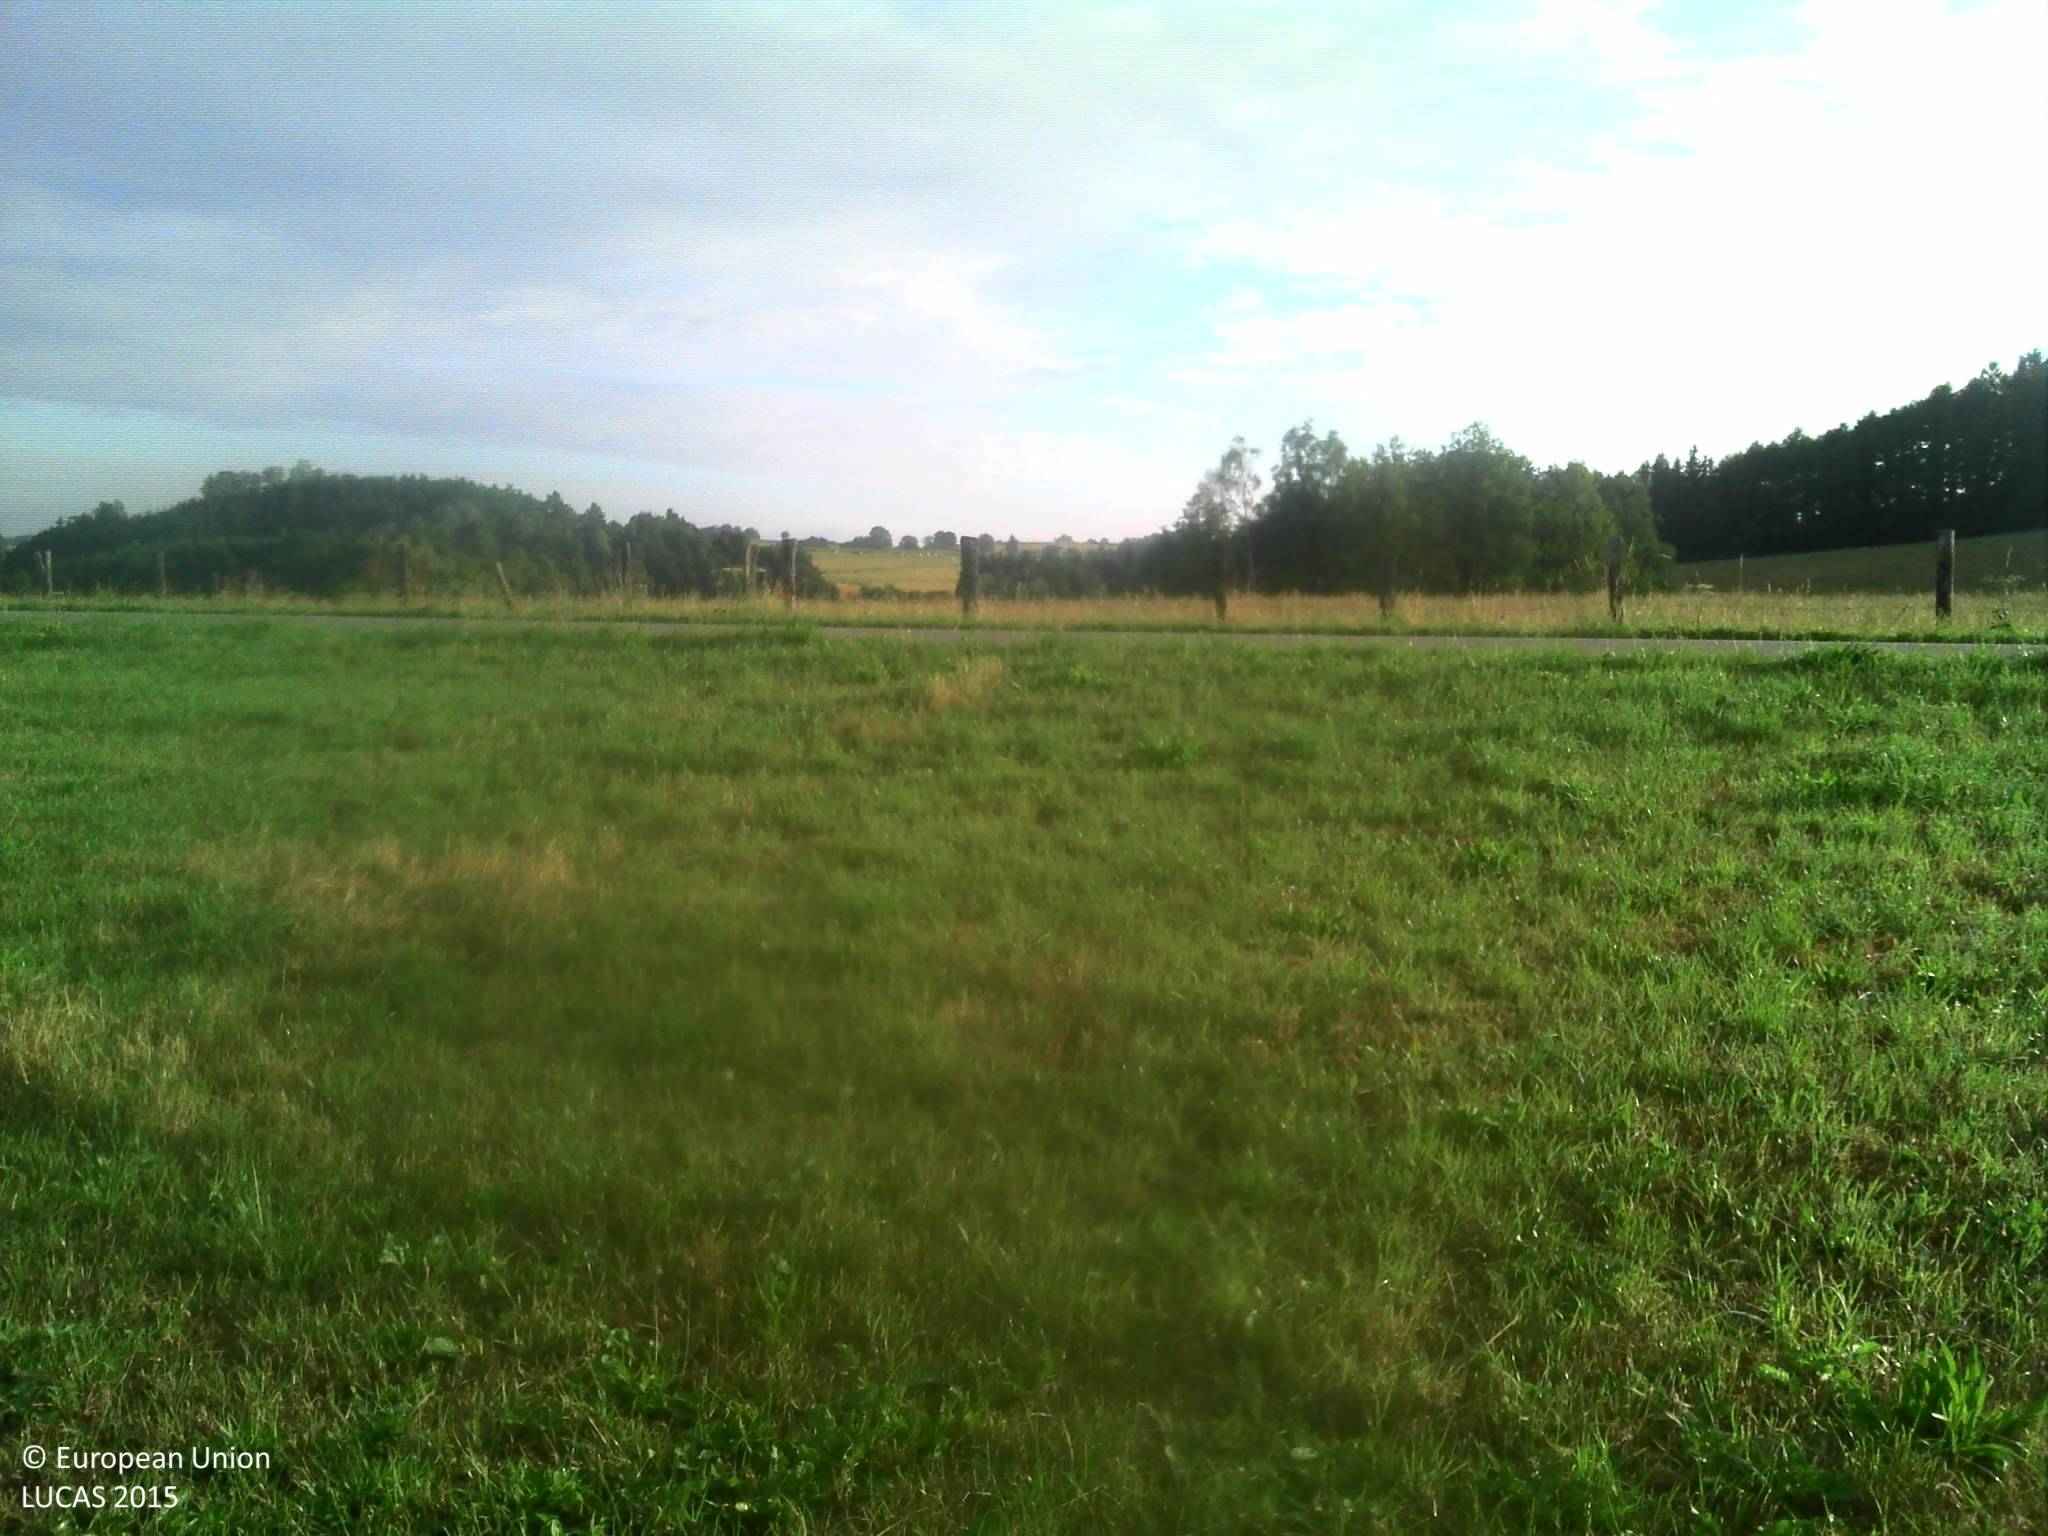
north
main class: Grassland
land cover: Grassland without tree/shrub cover
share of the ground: > 75 %
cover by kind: herbaceous plants 100 %
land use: Agriculture (excluding fallow land and kitchen gardens)
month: July
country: BE
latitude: 49.8021
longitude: 5.3715
